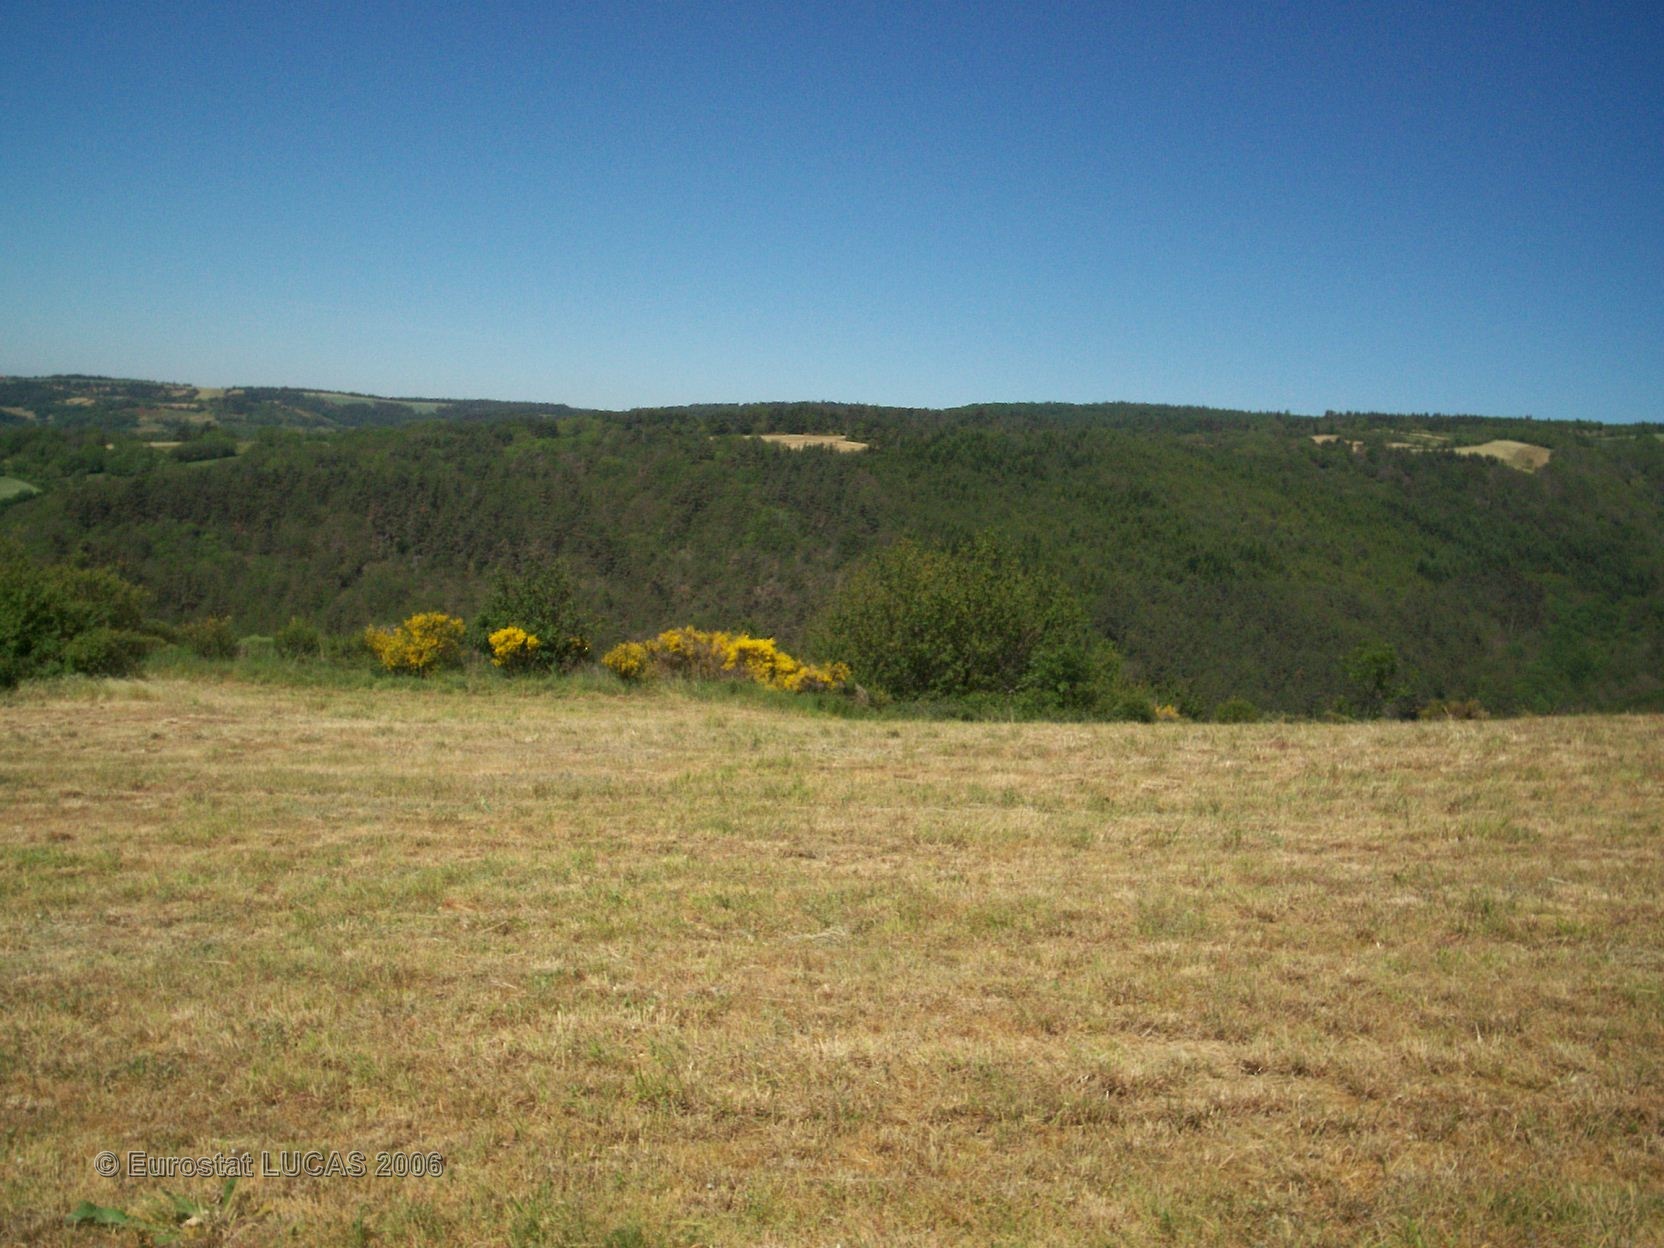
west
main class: Grassland
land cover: Grassland without tree/shrub cover
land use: Agriculture (excluding fallow land and kitchen gardens)
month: June
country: FR
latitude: 44.5398
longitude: 3.4227
